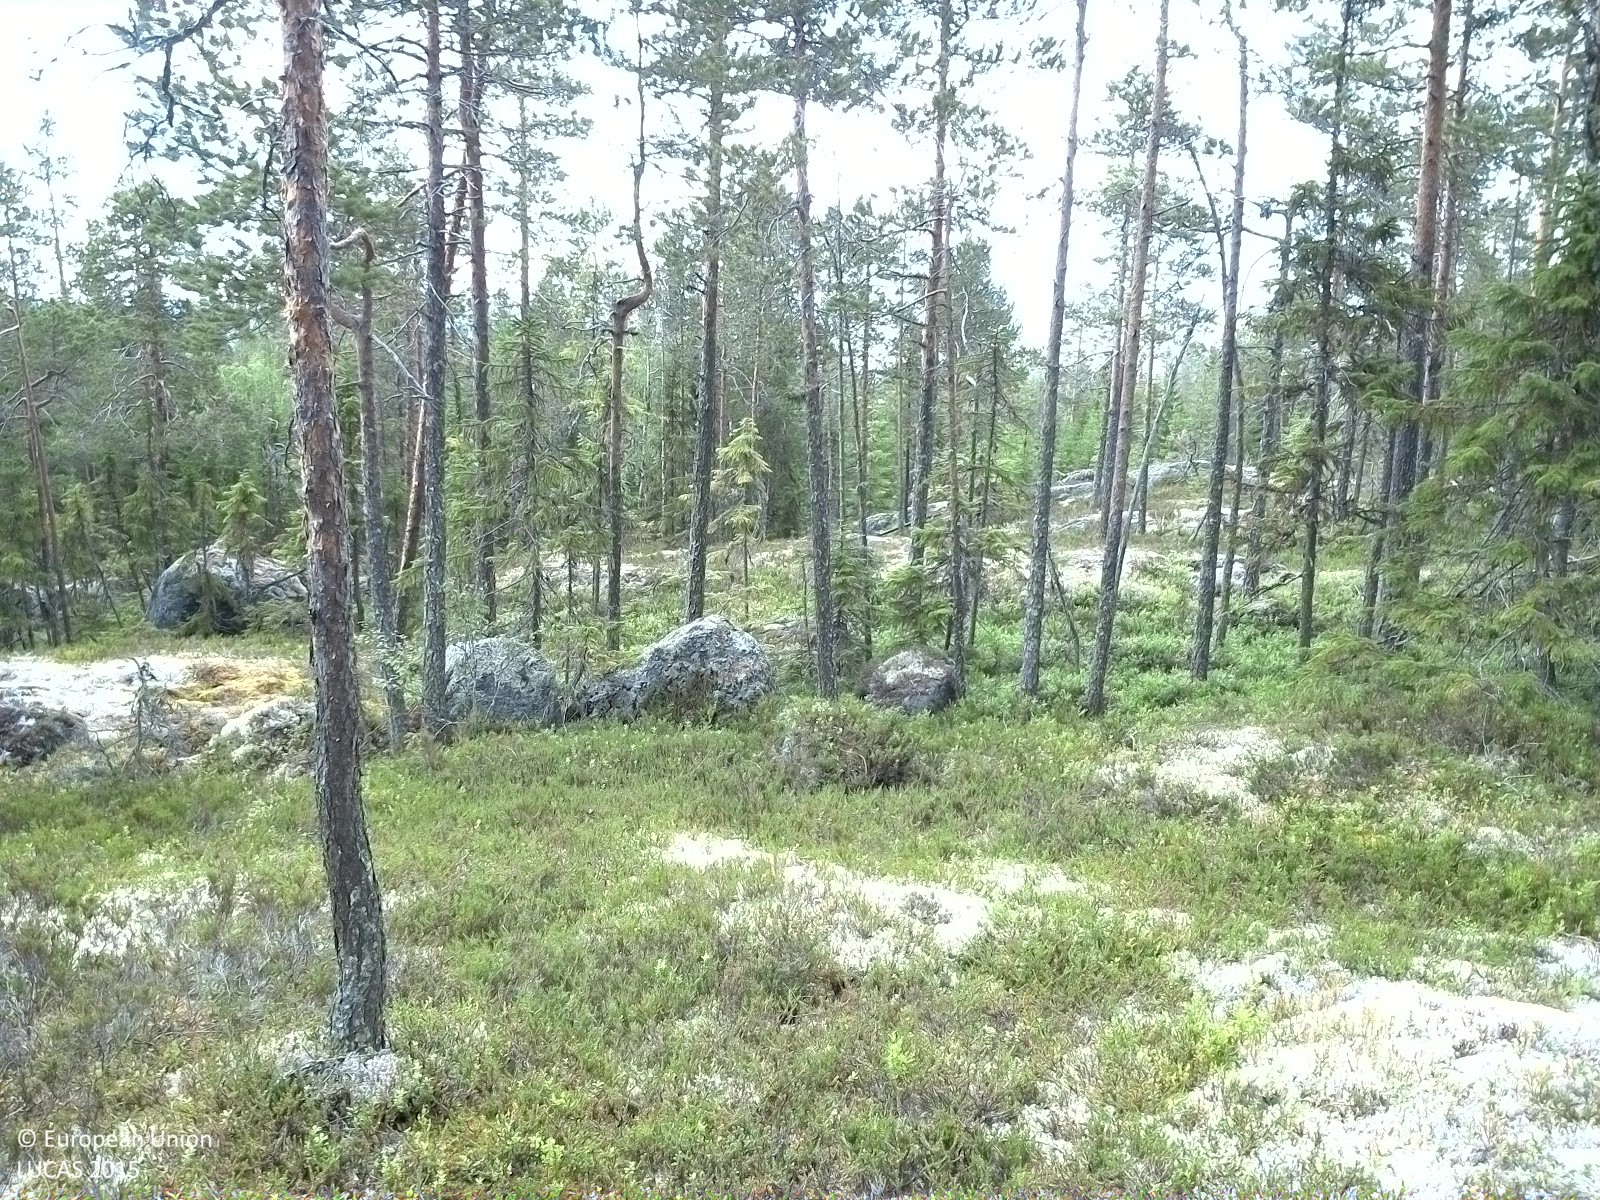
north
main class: Woodland
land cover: Pine dominated coniferous woodland
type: boreal forest
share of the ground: 10 - 25 %
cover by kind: shrubs 35 %, lichens and mosses 30 %, unconsolidated bare surface 20 %, coniferous forest trees 15 %
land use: Forestry
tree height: > 5 m
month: July
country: SE
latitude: 62.6368
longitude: 17.2532
